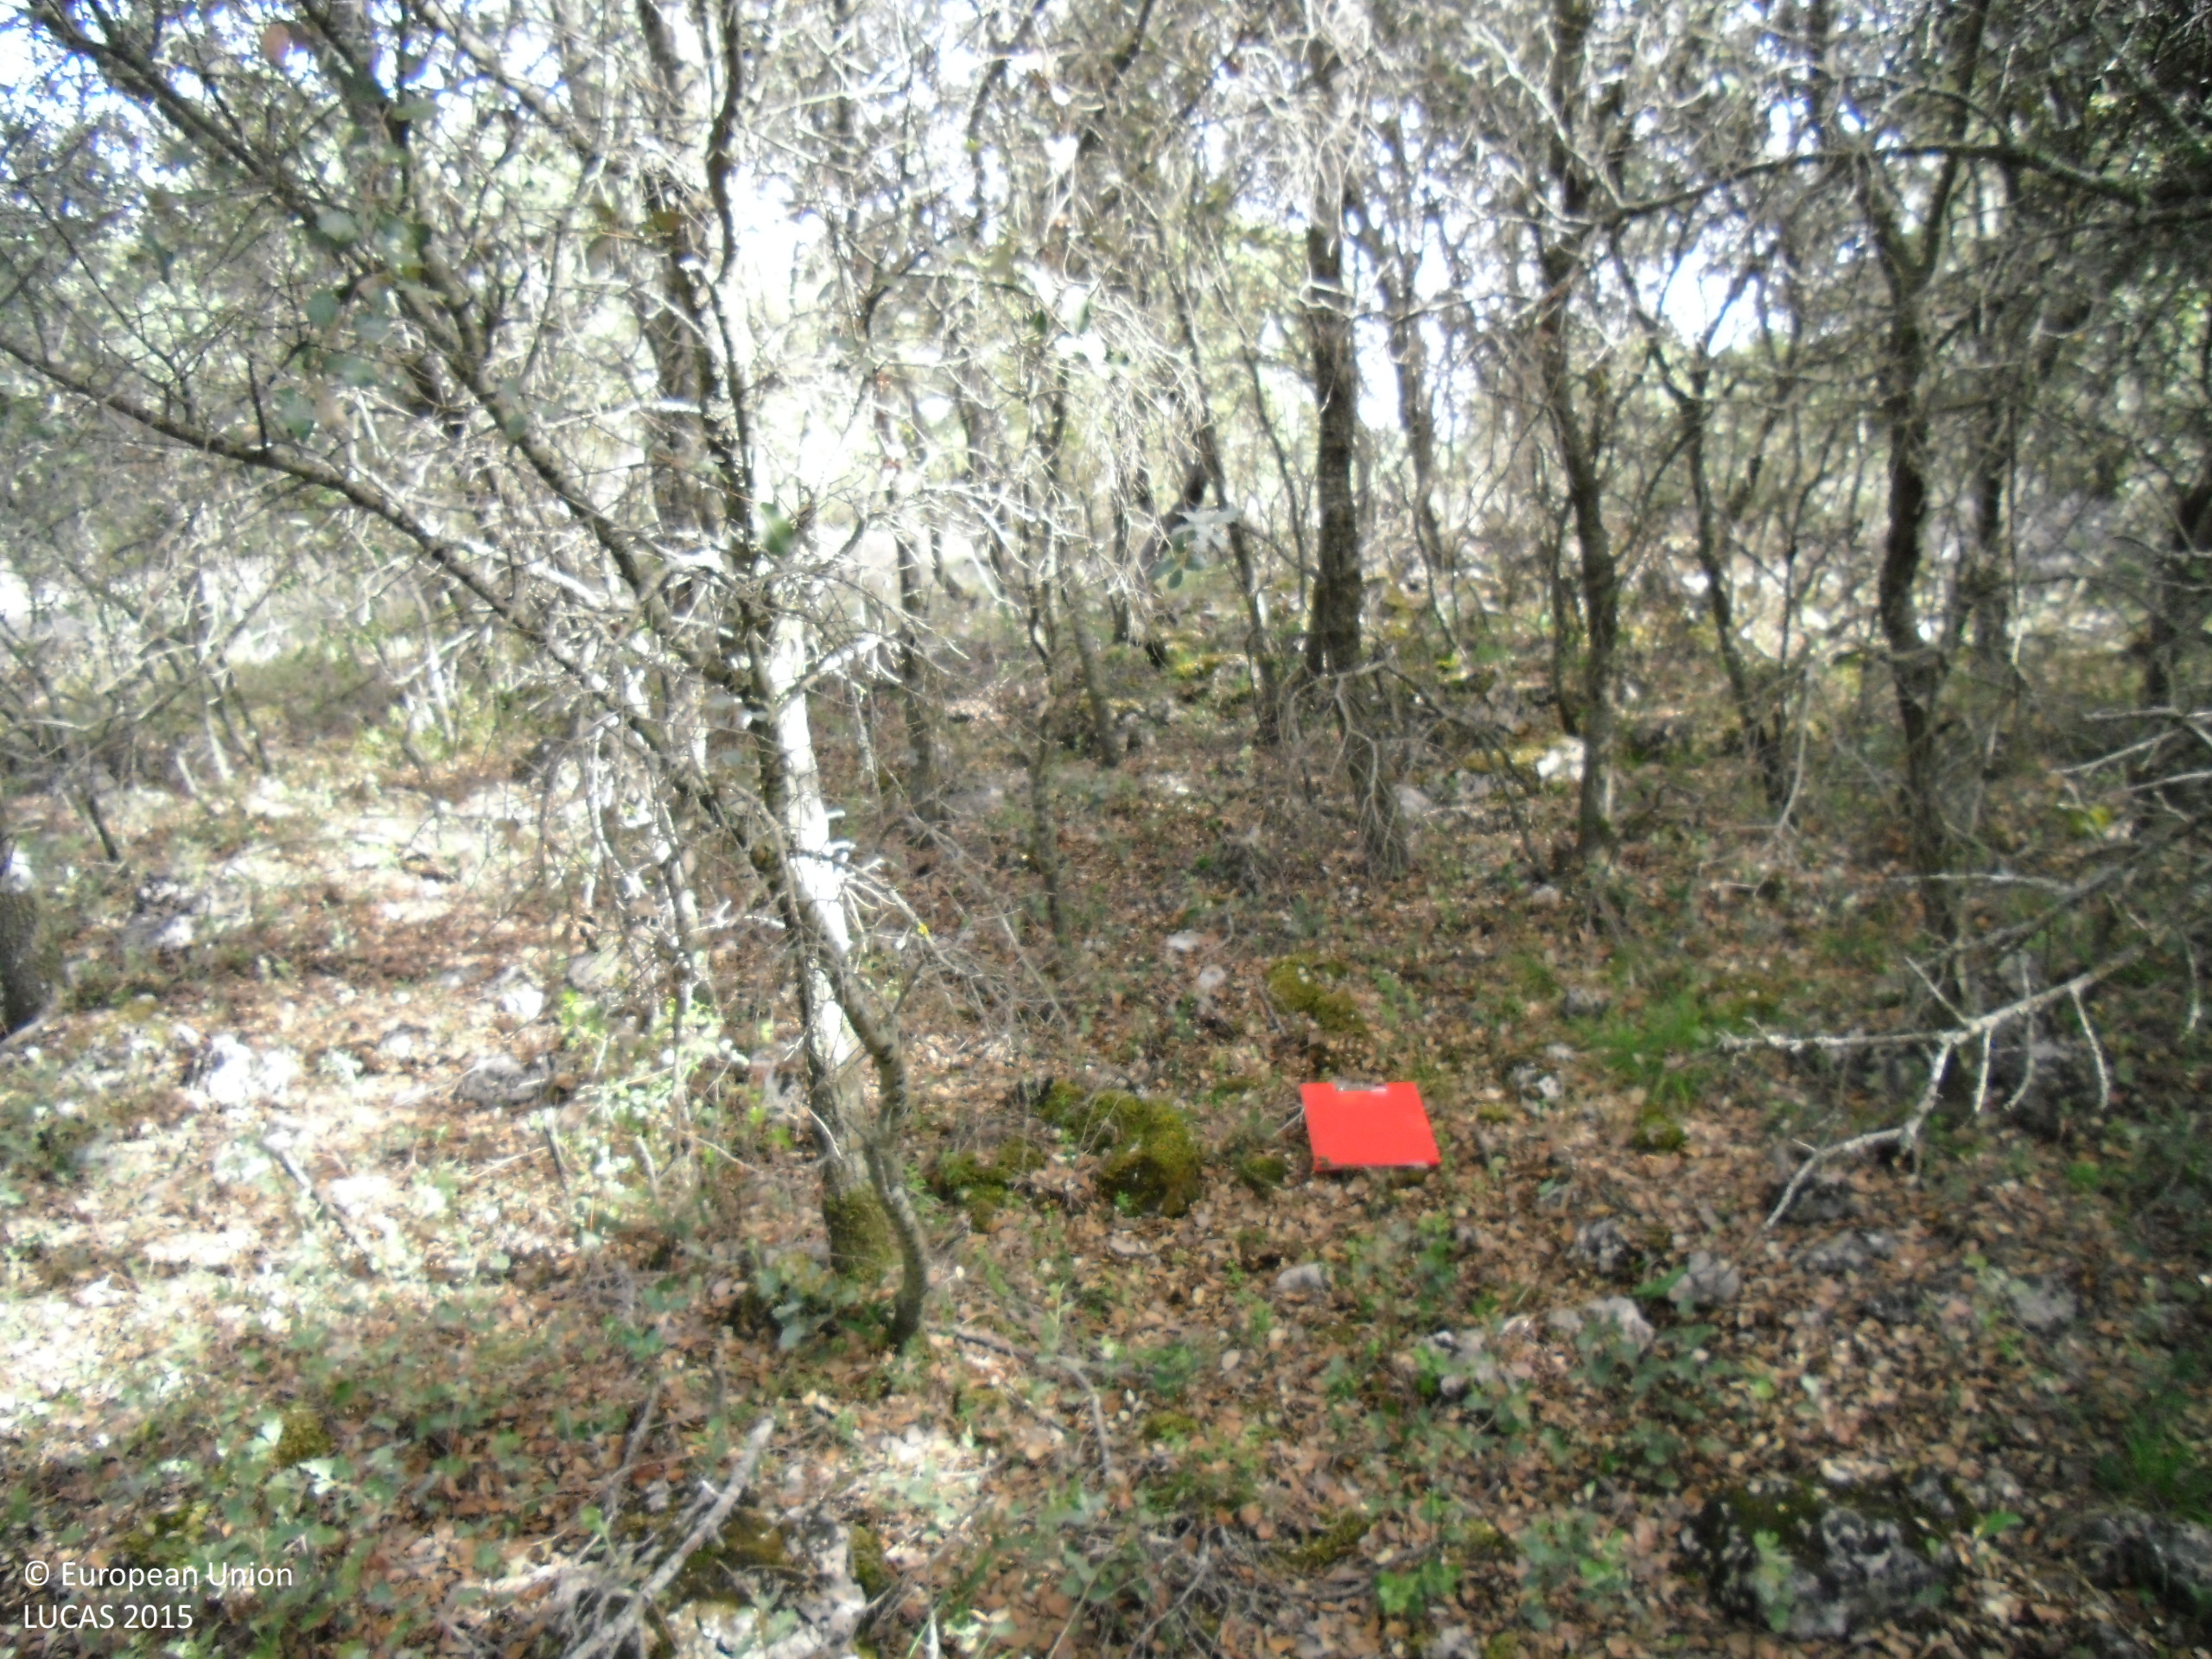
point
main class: Woodland
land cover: Broadleaved woodland
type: thermophilous deciduous forest
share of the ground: > 75 %
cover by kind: broadleaved forest trees 95 %, herbaceous plants 5 %
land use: Semi-natural and natural areas not in use
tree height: > 5 m
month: May
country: ES
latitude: 40.4733
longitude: -2.8967
